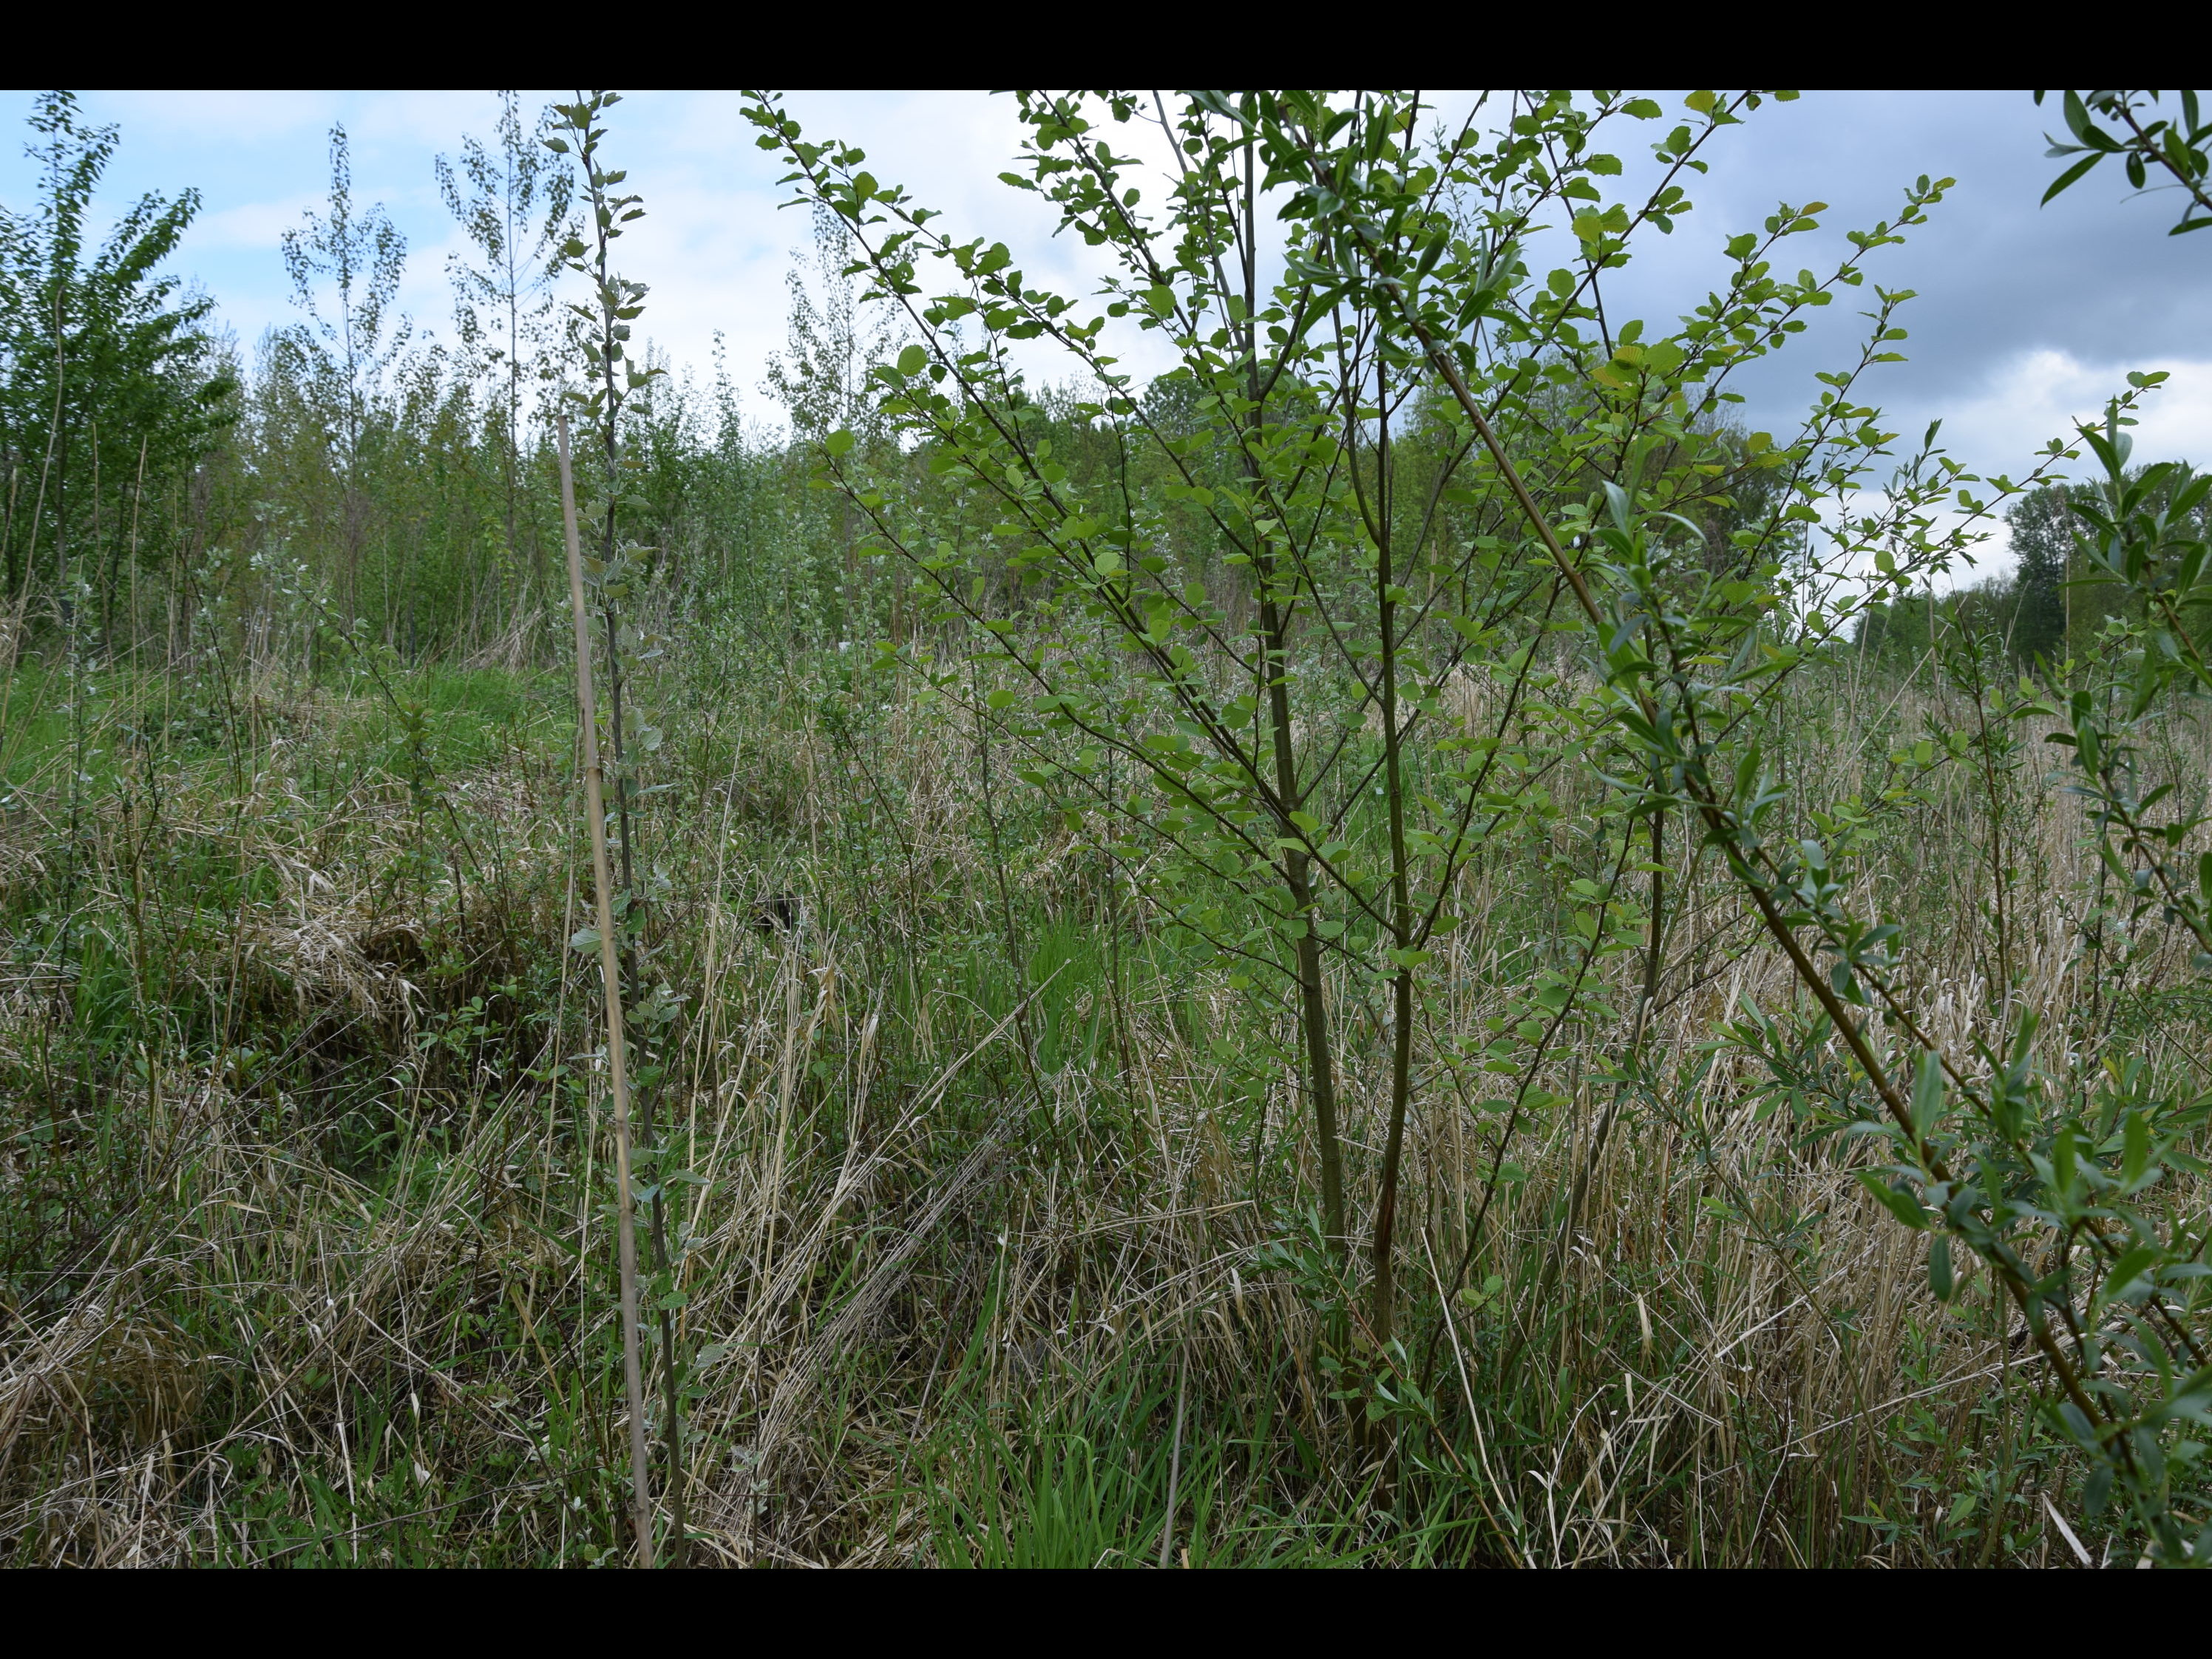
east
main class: Shrubland
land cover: Shrubland with sparse tree cover
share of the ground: > 75 %
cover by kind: herbaceous plants 80 %, shrubs 15 %, broadleaved forest trees 5 %
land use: Semi-natural and natural areas not in use
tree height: < 5 m
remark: Temporary flooded
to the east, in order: Shrubland with sparse tree cover; Broadleaved woodland; Grassland with sparse tree/shrub cover; Tracks; Grassland with sparse tree/shrub cover; Broadleaved woodland; Tracks; Broadleaved woodland; Tracks; Grass margins; Maize
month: May
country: AT
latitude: 48.1990
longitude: 14.6153
